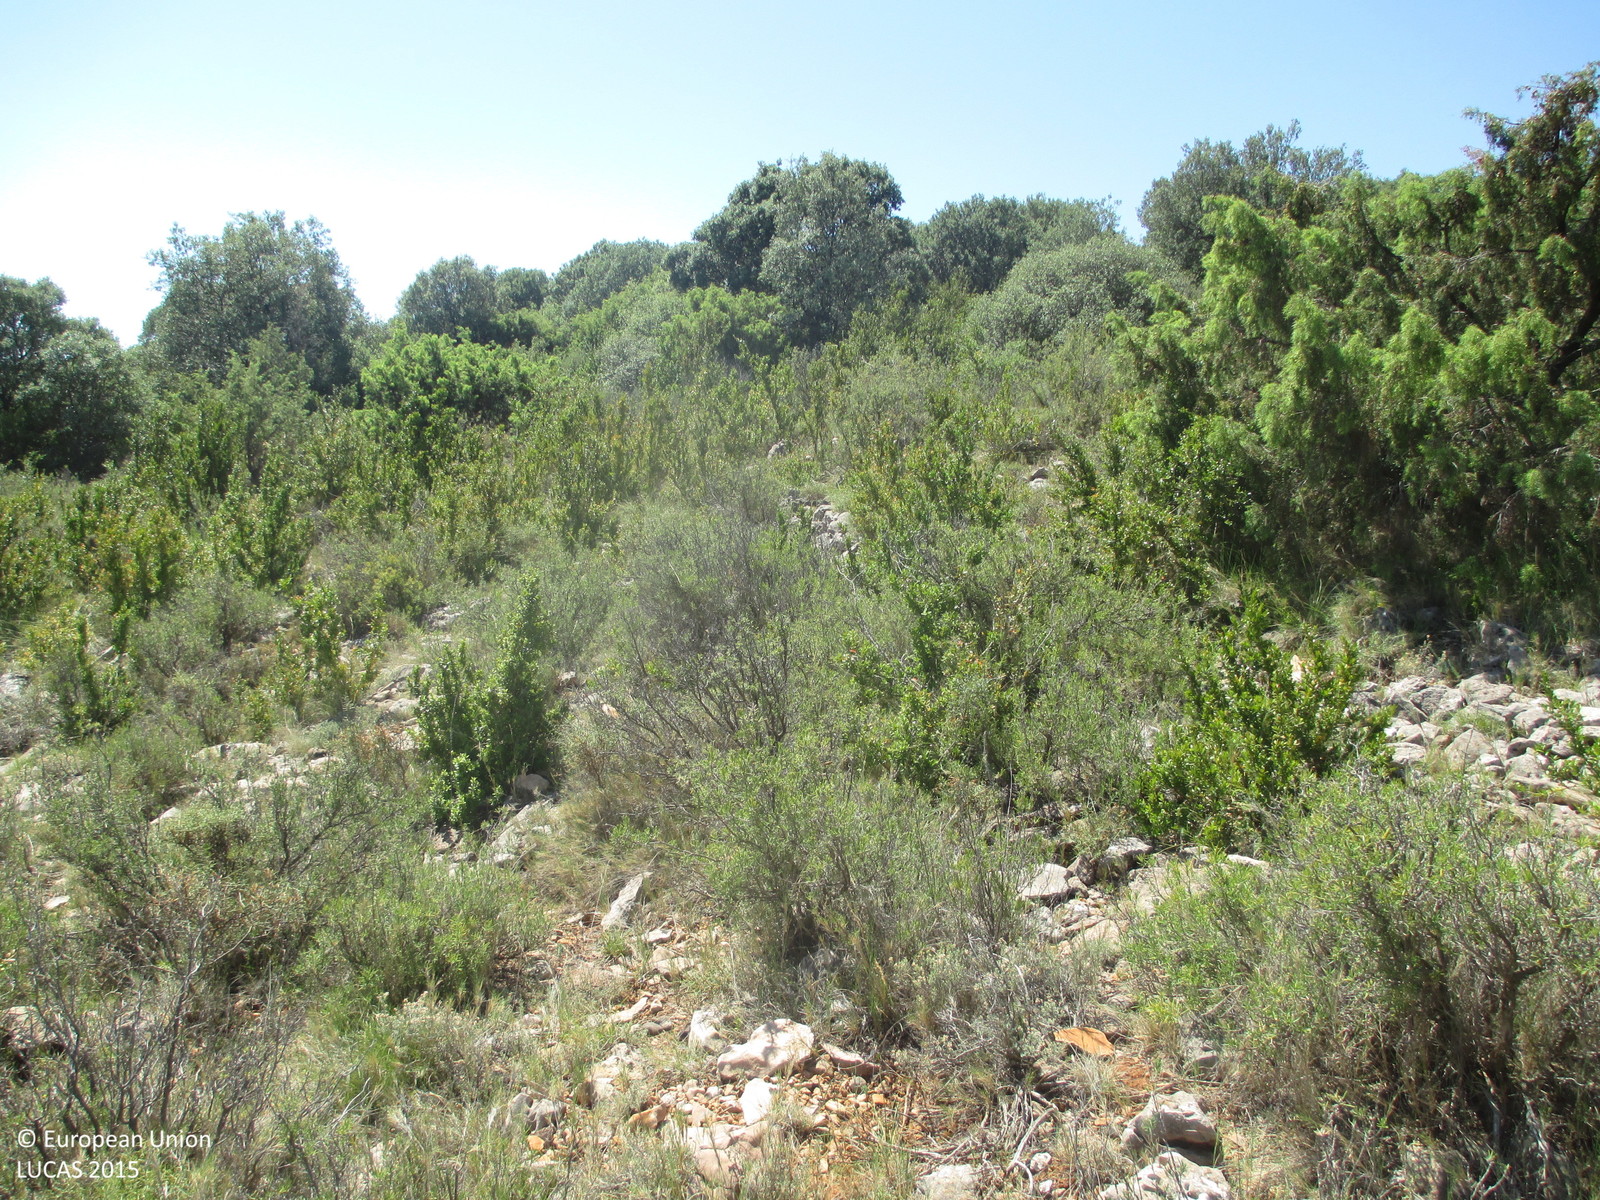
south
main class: Shrubland
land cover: Shrubland without tree cover
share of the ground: > 75 %
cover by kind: shrubs 95 %, herbaceous plants 5 %
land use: Semi-natural and natural areas not in use
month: June
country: ES
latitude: 42.1778
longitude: 0.0163
